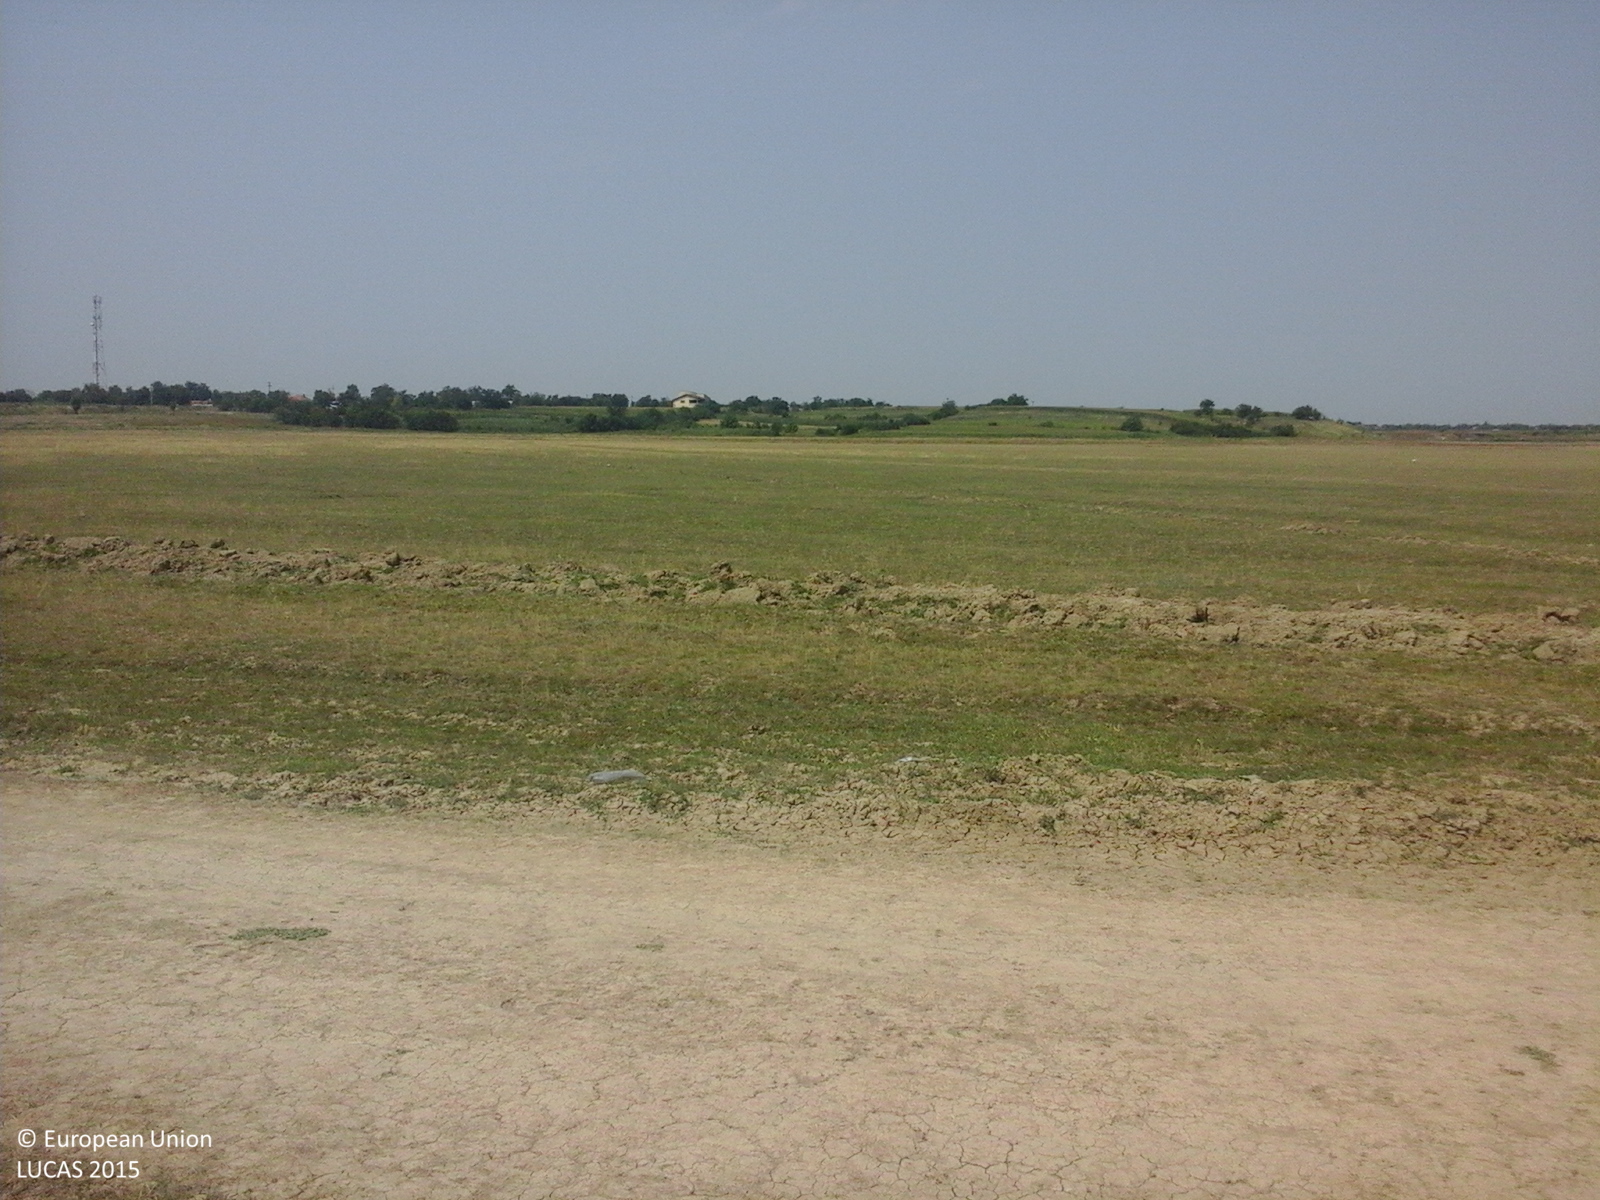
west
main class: Grassland
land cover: Grassland without tree/shrub cover
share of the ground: > 75 %
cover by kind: herbaceous plants 100 %
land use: Agriculture (excluding fallow land and kitchen gardens)
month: July
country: RO
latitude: 44.7558
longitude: 26.5544
